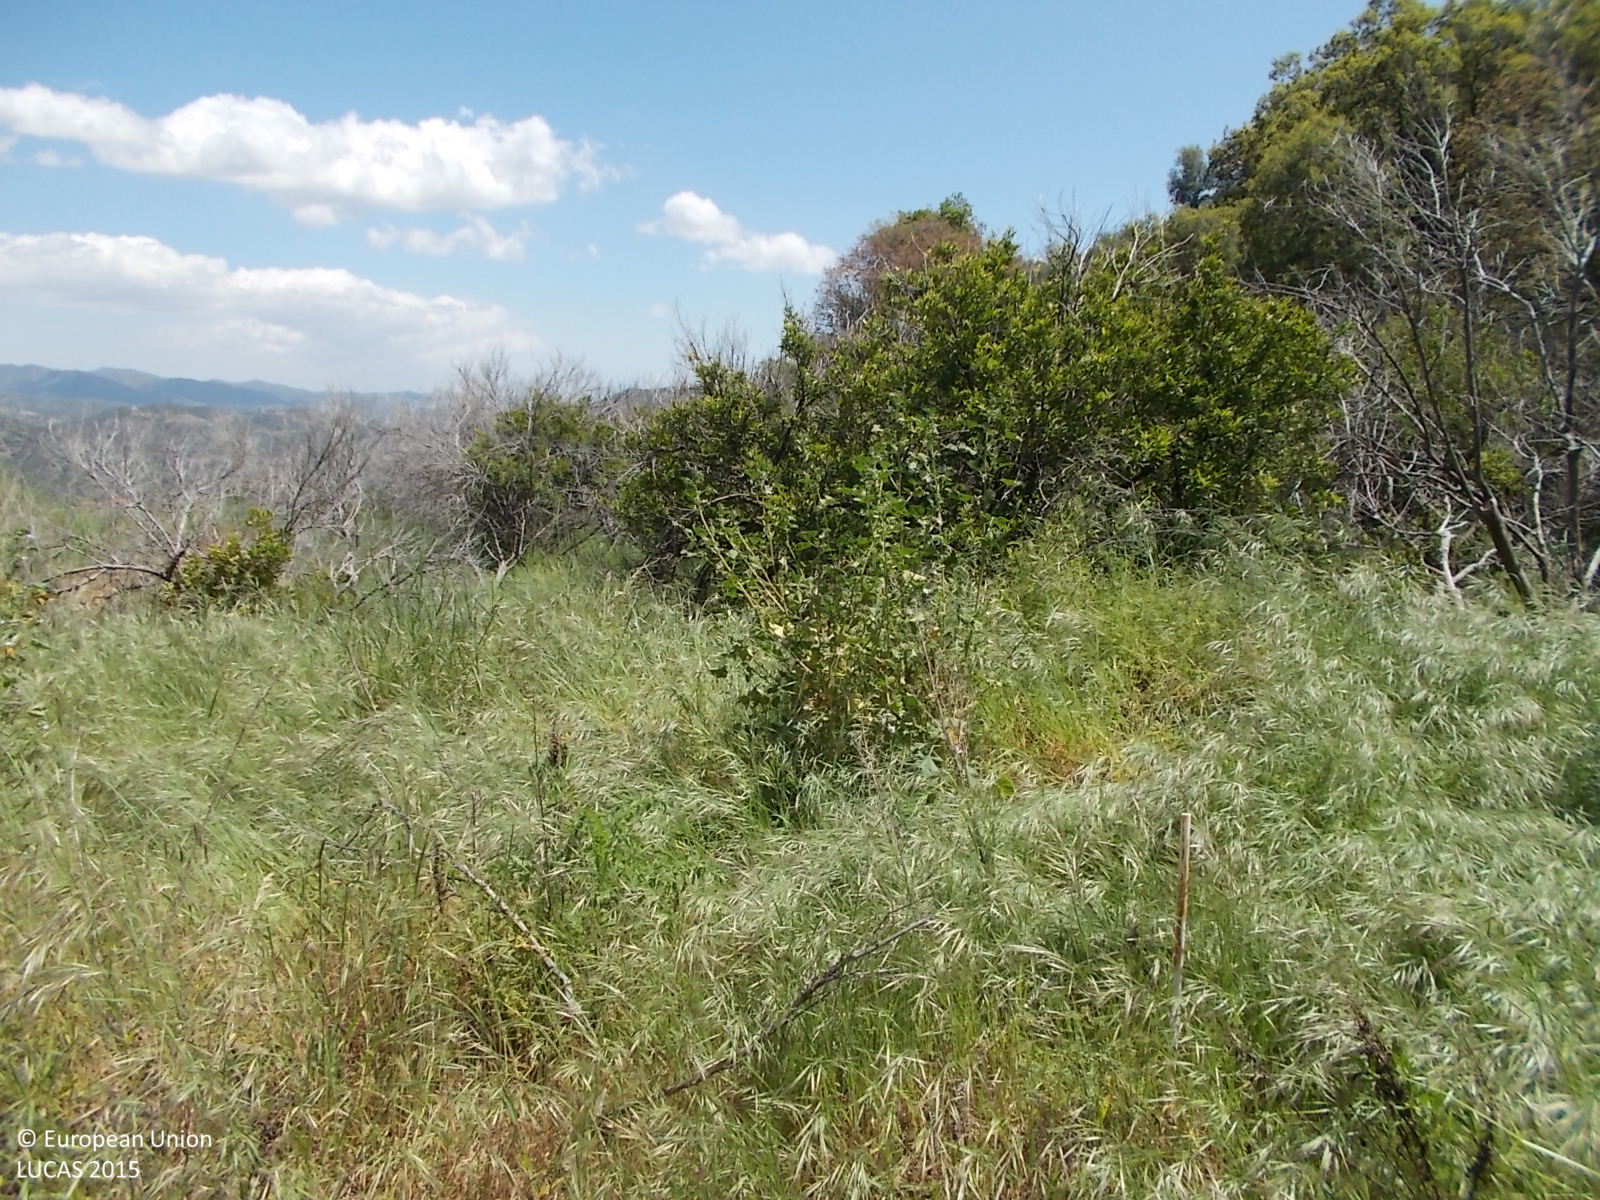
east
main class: Cropland
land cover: Other citrus fruit
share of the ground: 10 - 25 %
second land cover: Spontaneously vegetated surfaces
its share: > 75 %
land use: Abandoned areas
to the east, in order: Other citrus fruit; Spontaneously vegetated surfaces; Oranges; Other mixed woodland; Pine dominated coniferous woodland
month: April
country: CY
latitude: 34.8248
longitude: 33.0994
